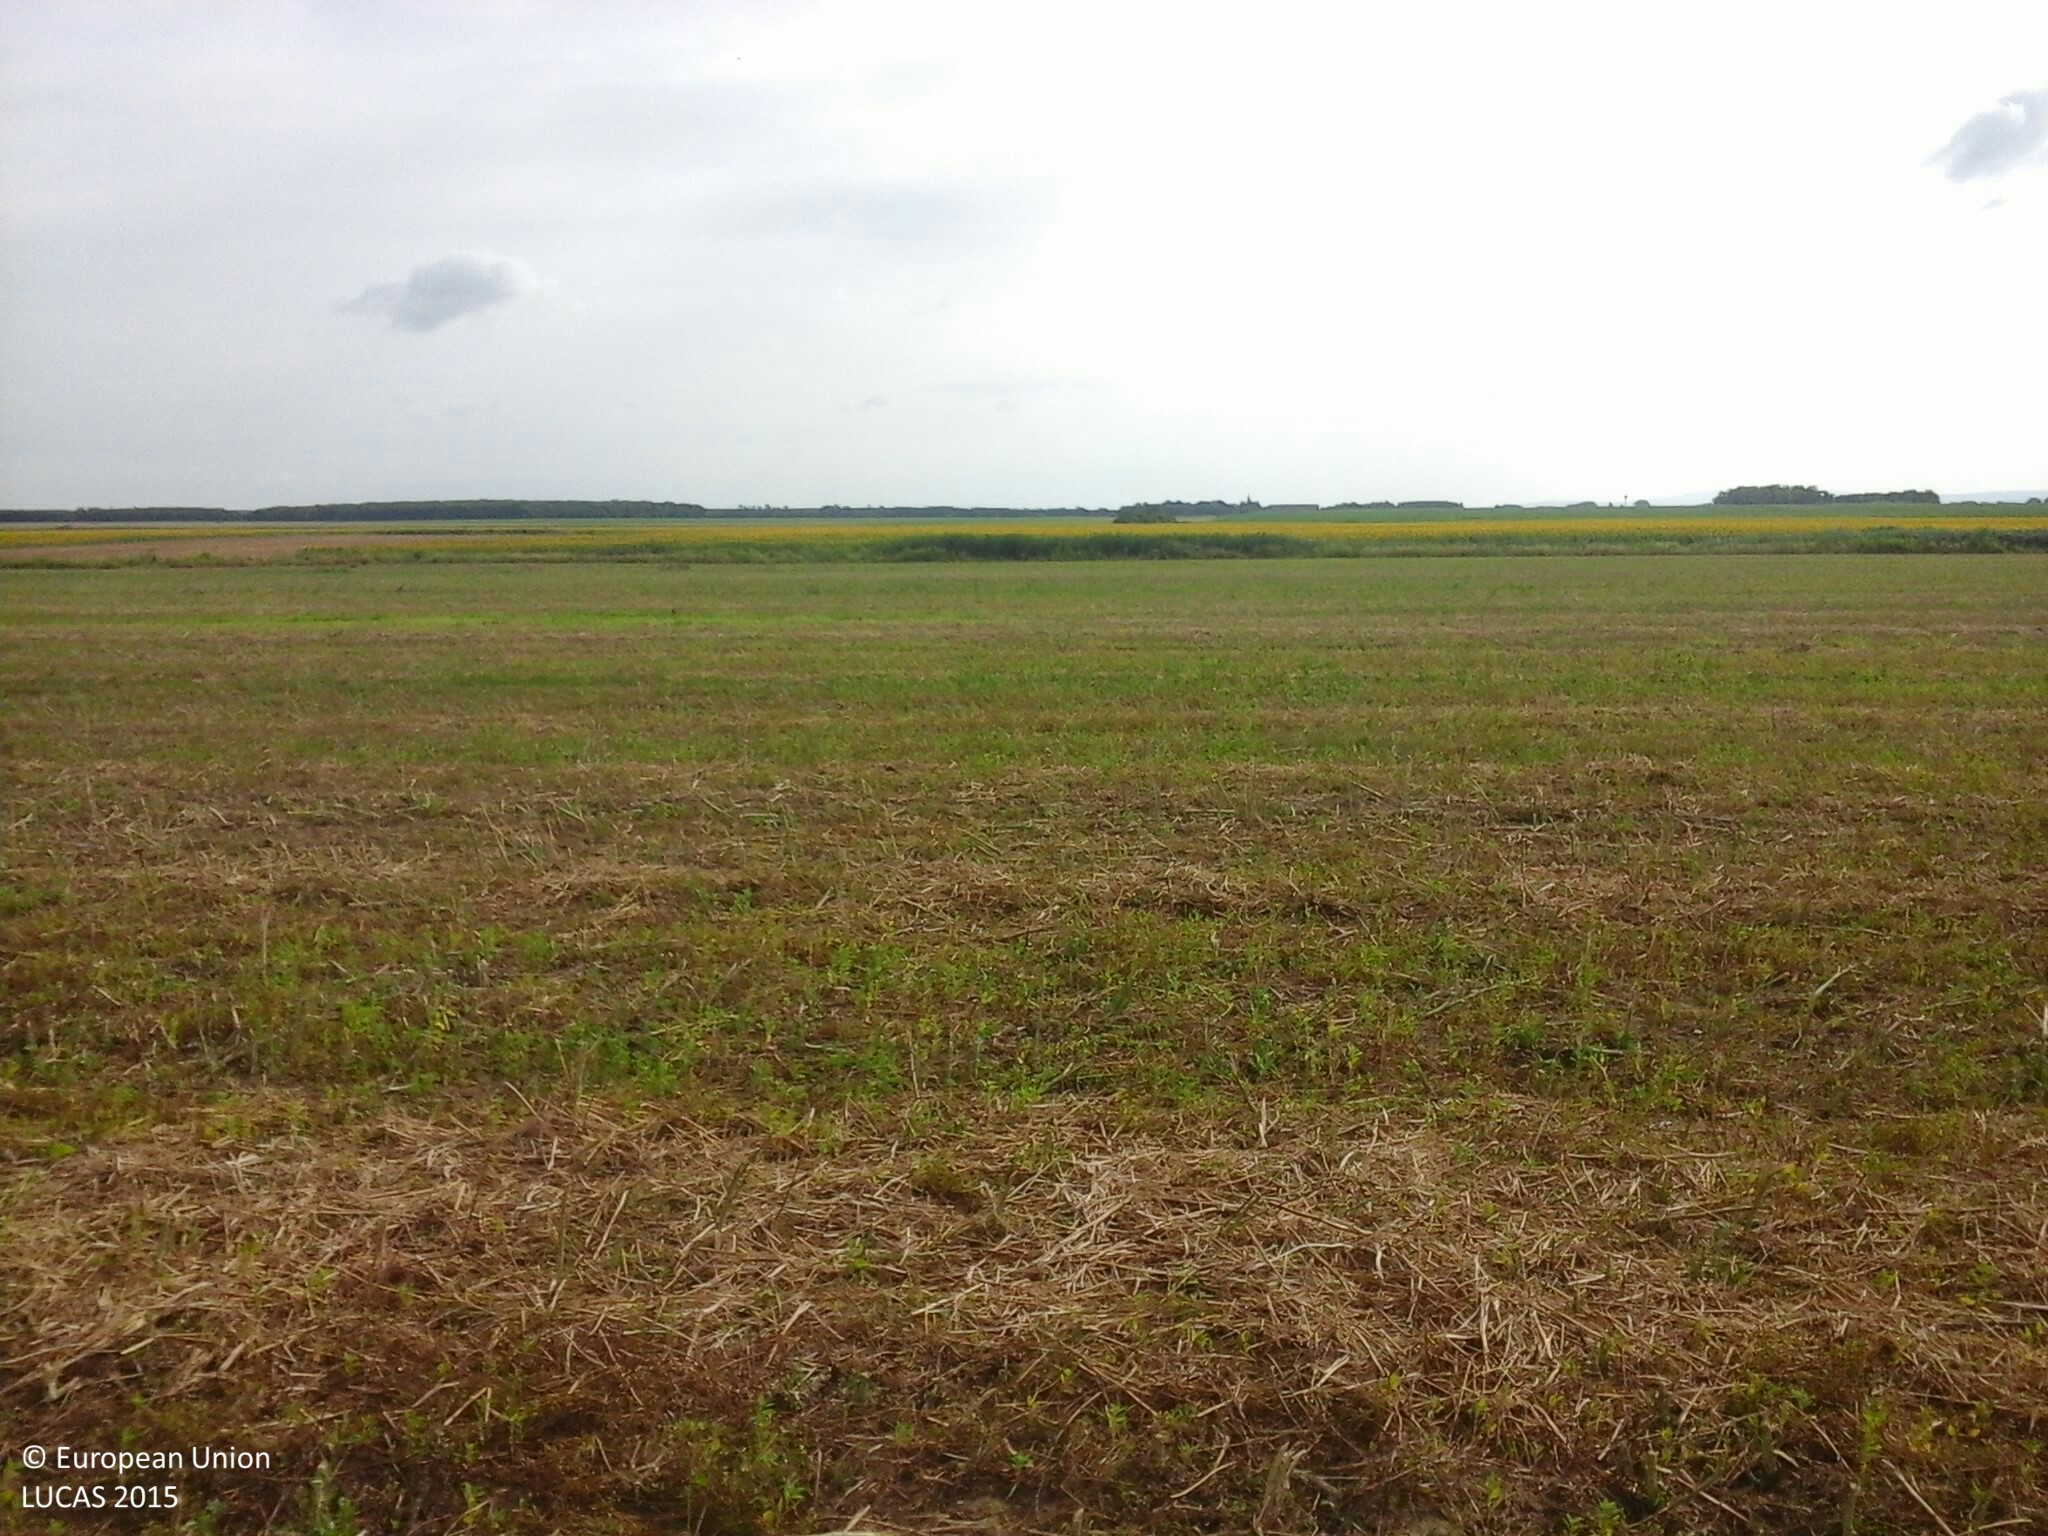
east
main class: Cropland
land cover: Rape and turnip rape
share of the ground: 10 - 25 %
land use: Agriculture (excluding fallow land and kitchen gardens)
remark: Harvested field
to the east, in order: Rape and turnip rape; Grass margins; Ditches and canals; Grass margins; Sunflower
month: July
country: HU
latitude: 47.1860
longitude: 17.3041
